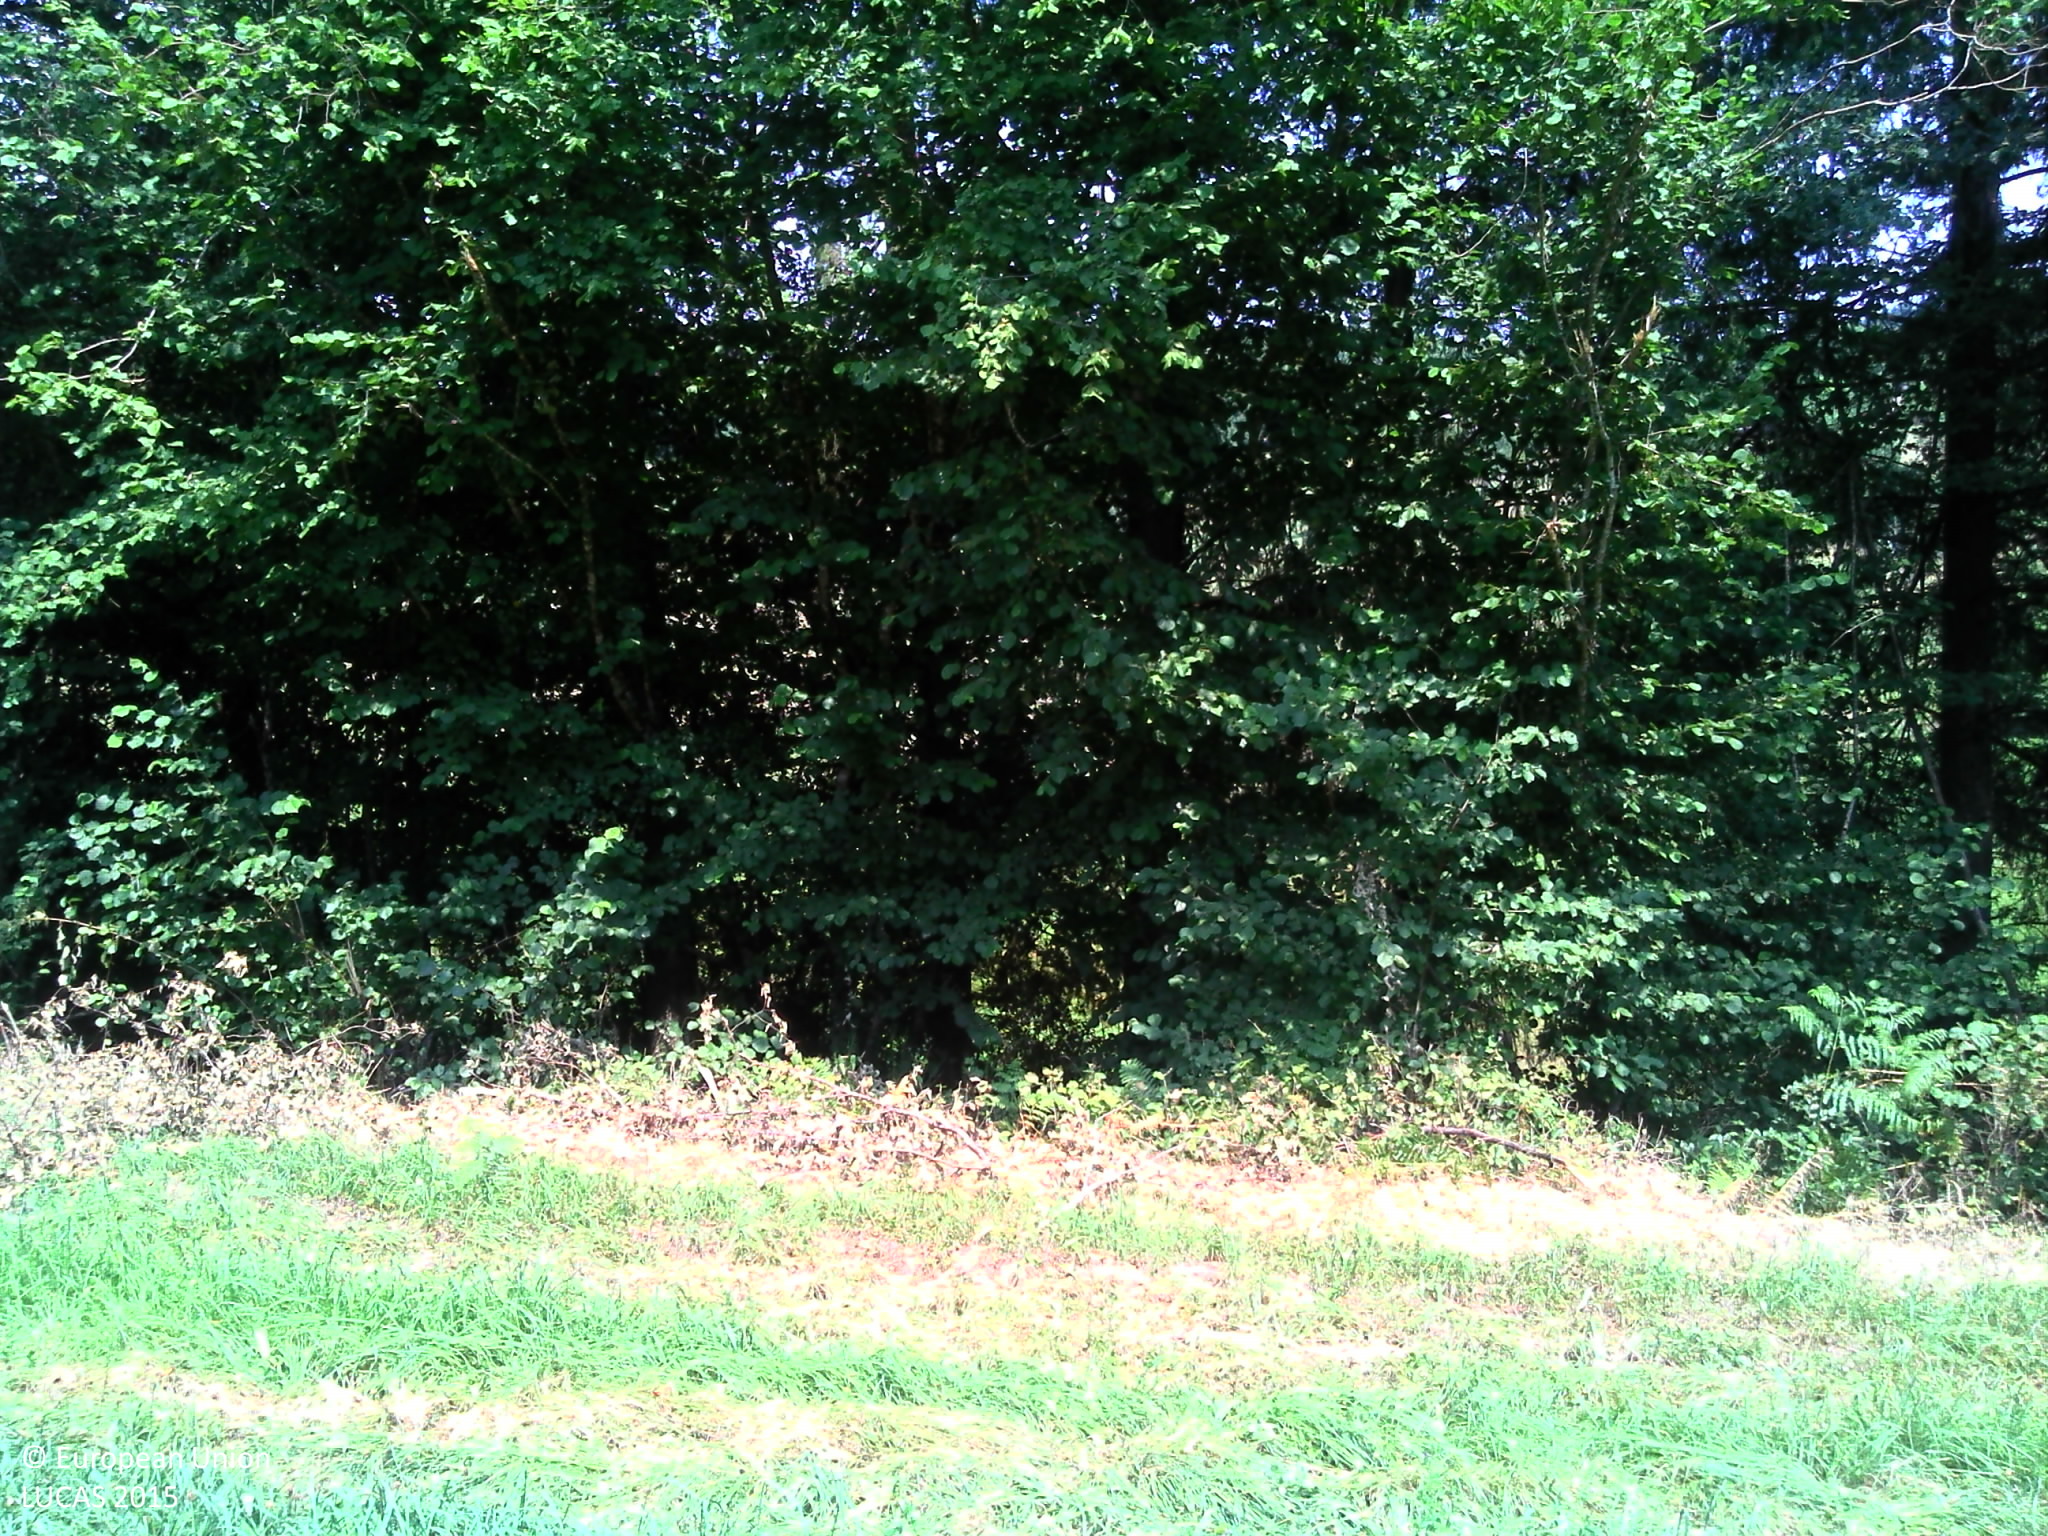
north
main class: Grassland
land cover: Grassland without tree/shrub cover
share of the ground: > 75 %
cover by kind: herbaceous plants 100 %
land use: Agriculture (excluding fallow land and kitchen gardens)
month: July
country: FR
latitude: 46.0172
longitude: 1.7913
